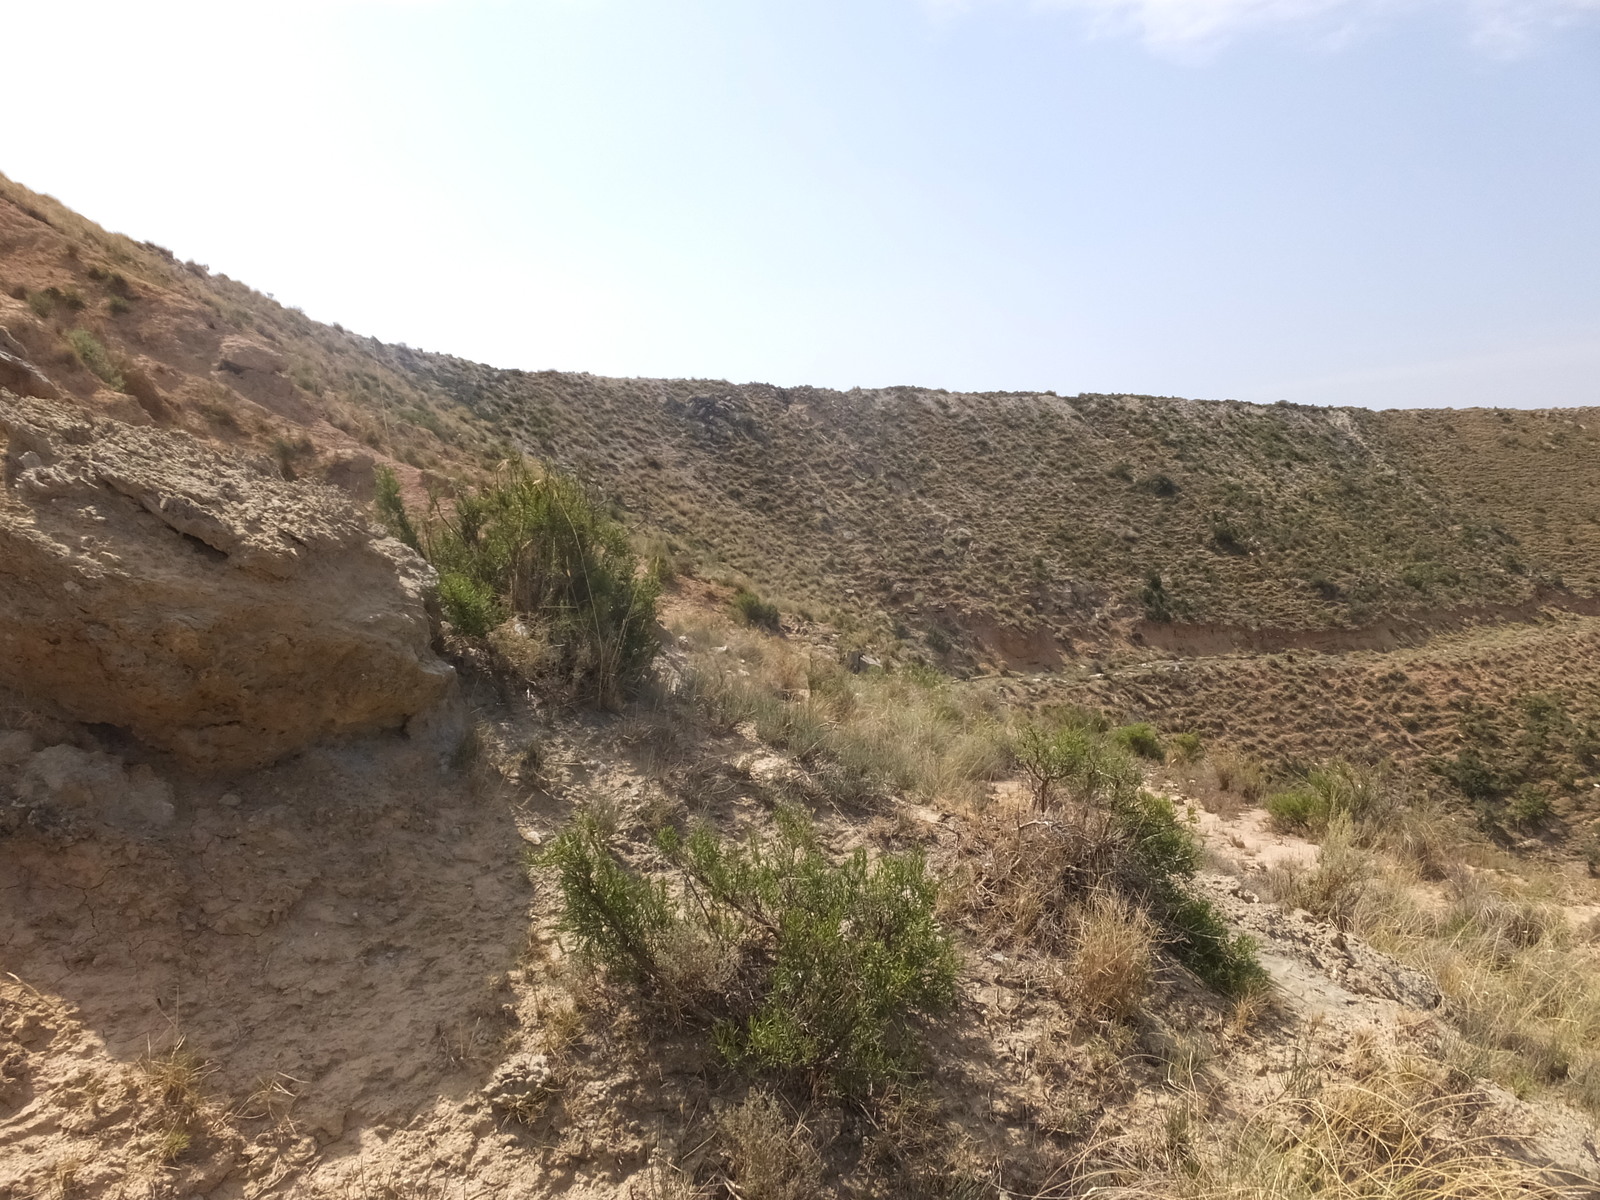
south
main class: Shrubland
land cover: Shrubland without tree cover
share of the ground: > 75 %
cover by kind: shrubs 65 %, consolidated bare surface 20 %, herbaceous plants 15 %
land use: Semi-natural and natural areas not in use
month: August
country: ES
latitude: 41.5545
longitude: 0.3352
